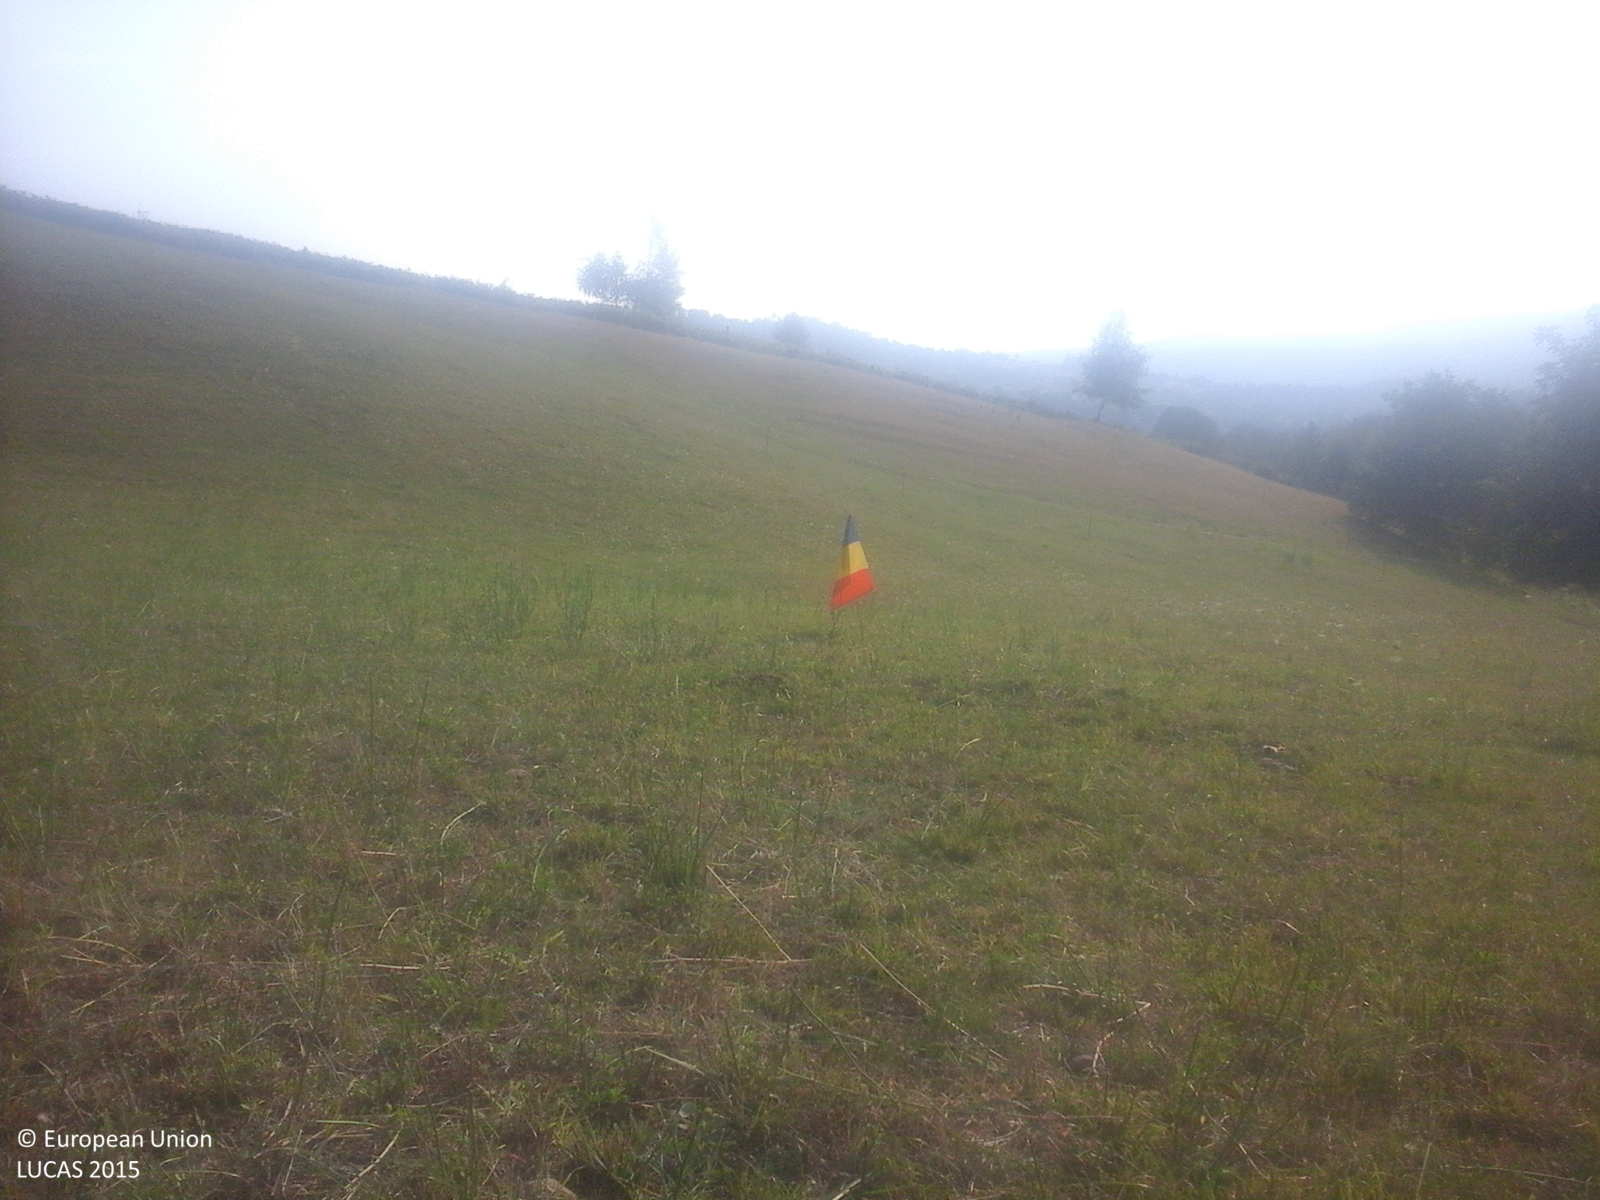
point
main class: Grassland
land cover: Grassland without tree/shrub cover
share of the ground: > 75 %
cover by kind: herbaceous plants 100 %
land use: Agriculture (excluding fallow land and kitchen gardens)
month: September
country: RO
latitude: 47.5891
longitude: 23.7896
